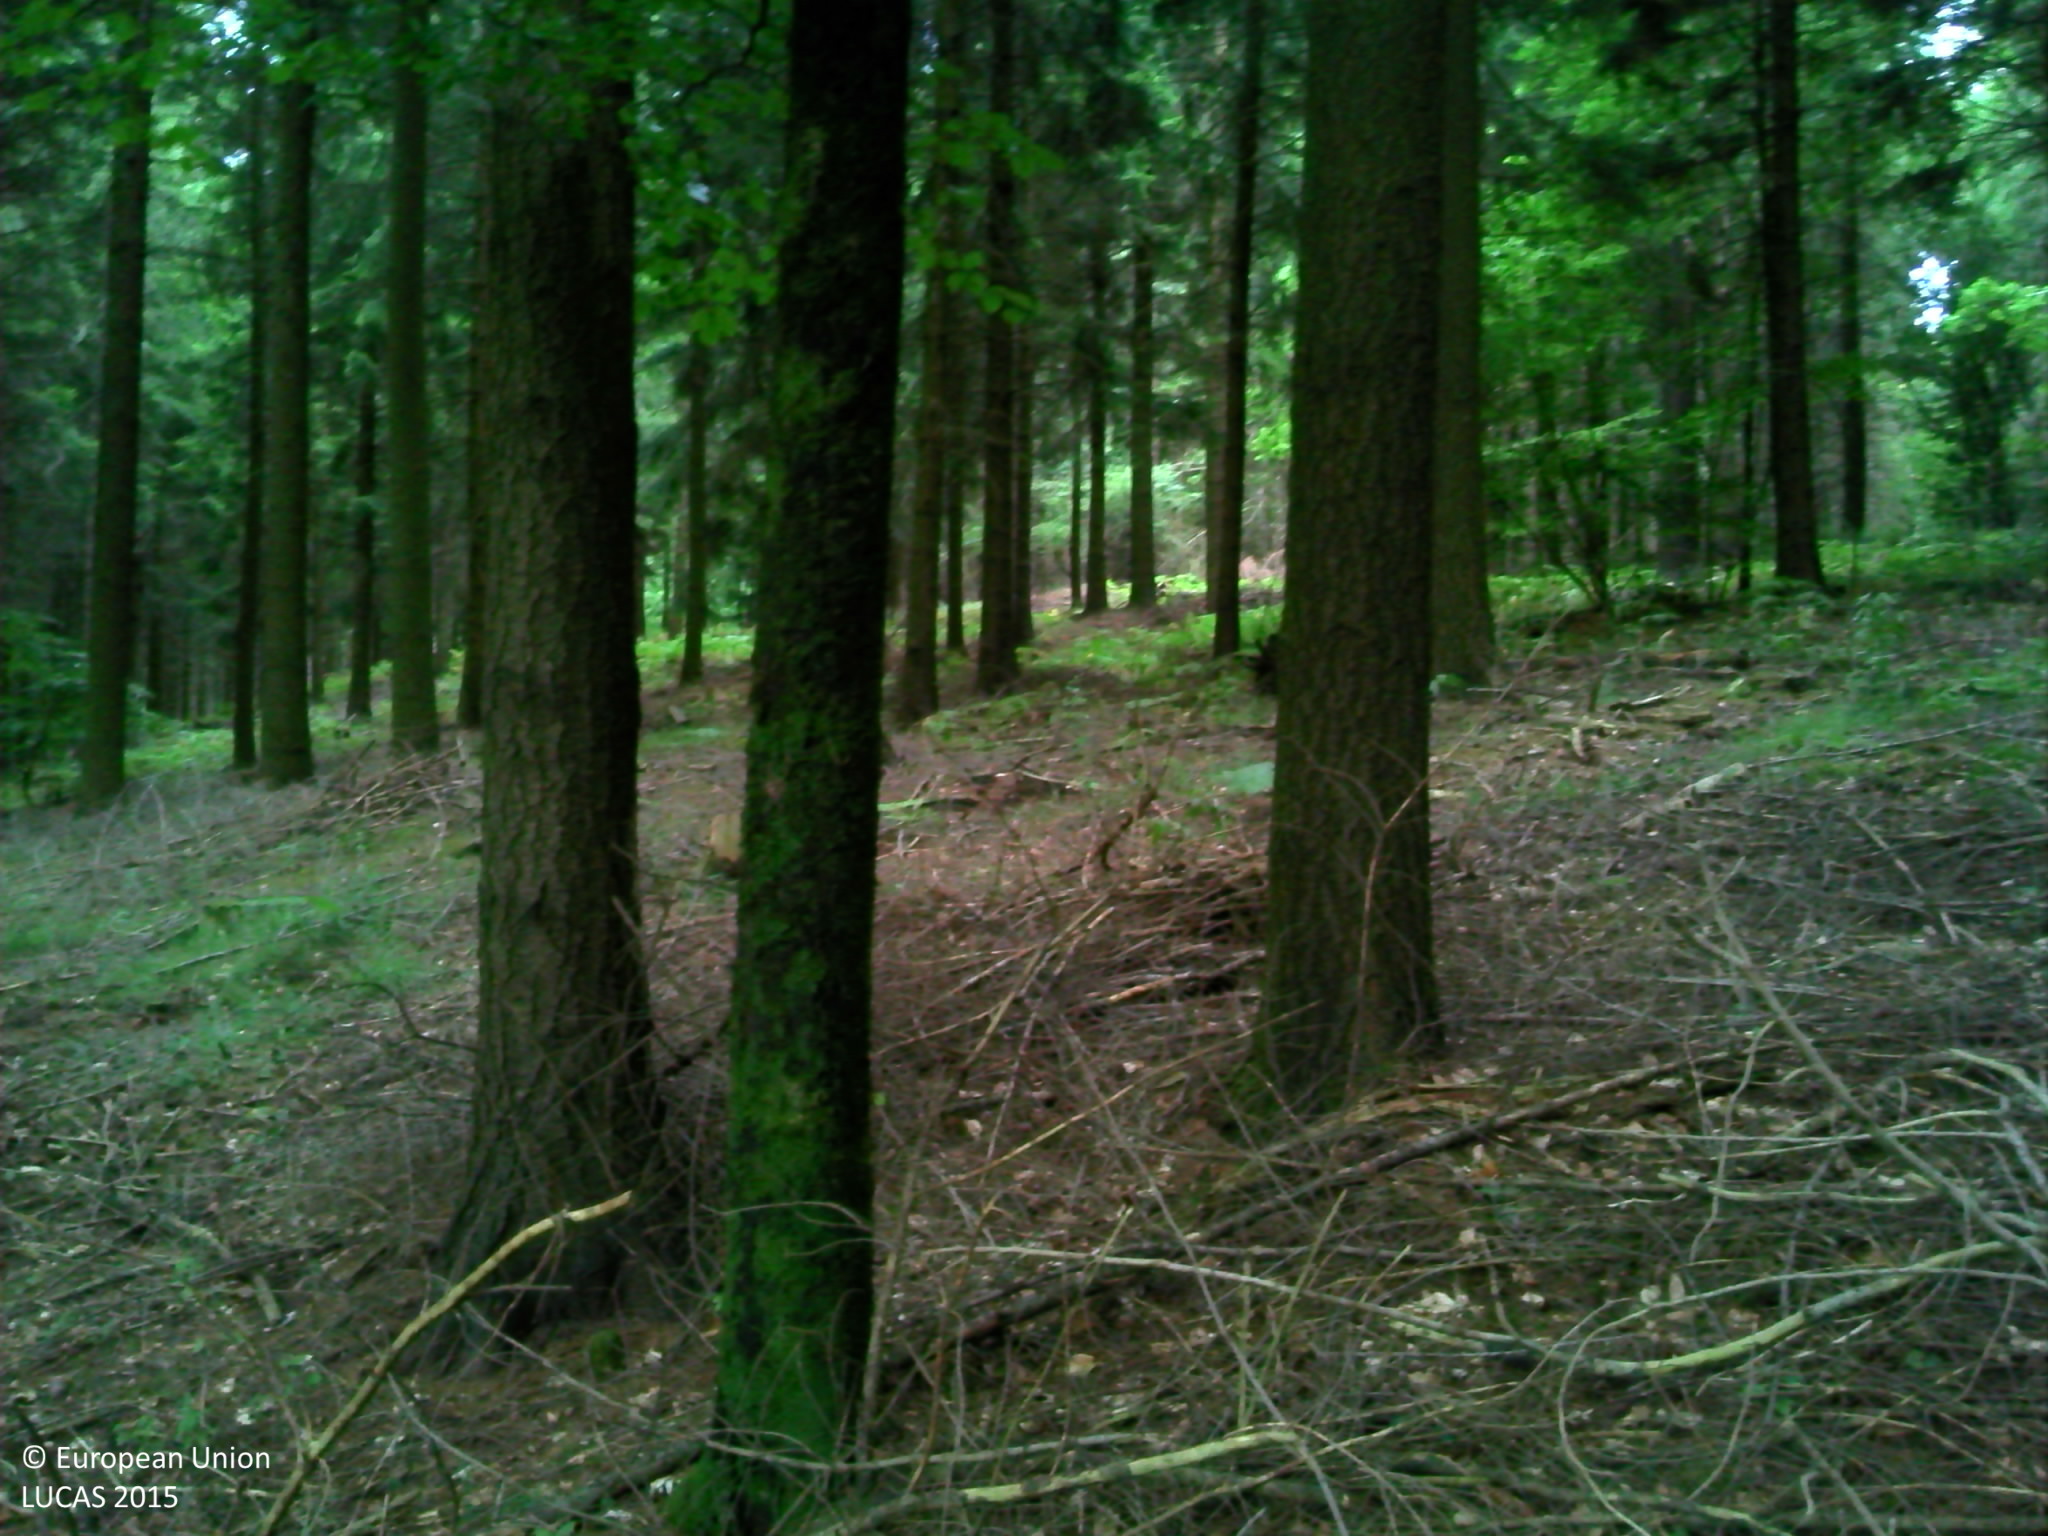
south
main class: Woodland
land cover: Spruce dominated coniferous woodland
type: exotic forest
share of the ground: > 75 %
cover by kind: coniferous forest trees 80 %, broadleaved forest trees 10 %, lichens and mosses 5 %, unconsolidated bare surface 5 %
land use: Forestry
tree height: > 5 m
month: July
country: FR
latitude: 43.5836
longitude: 2.6631
